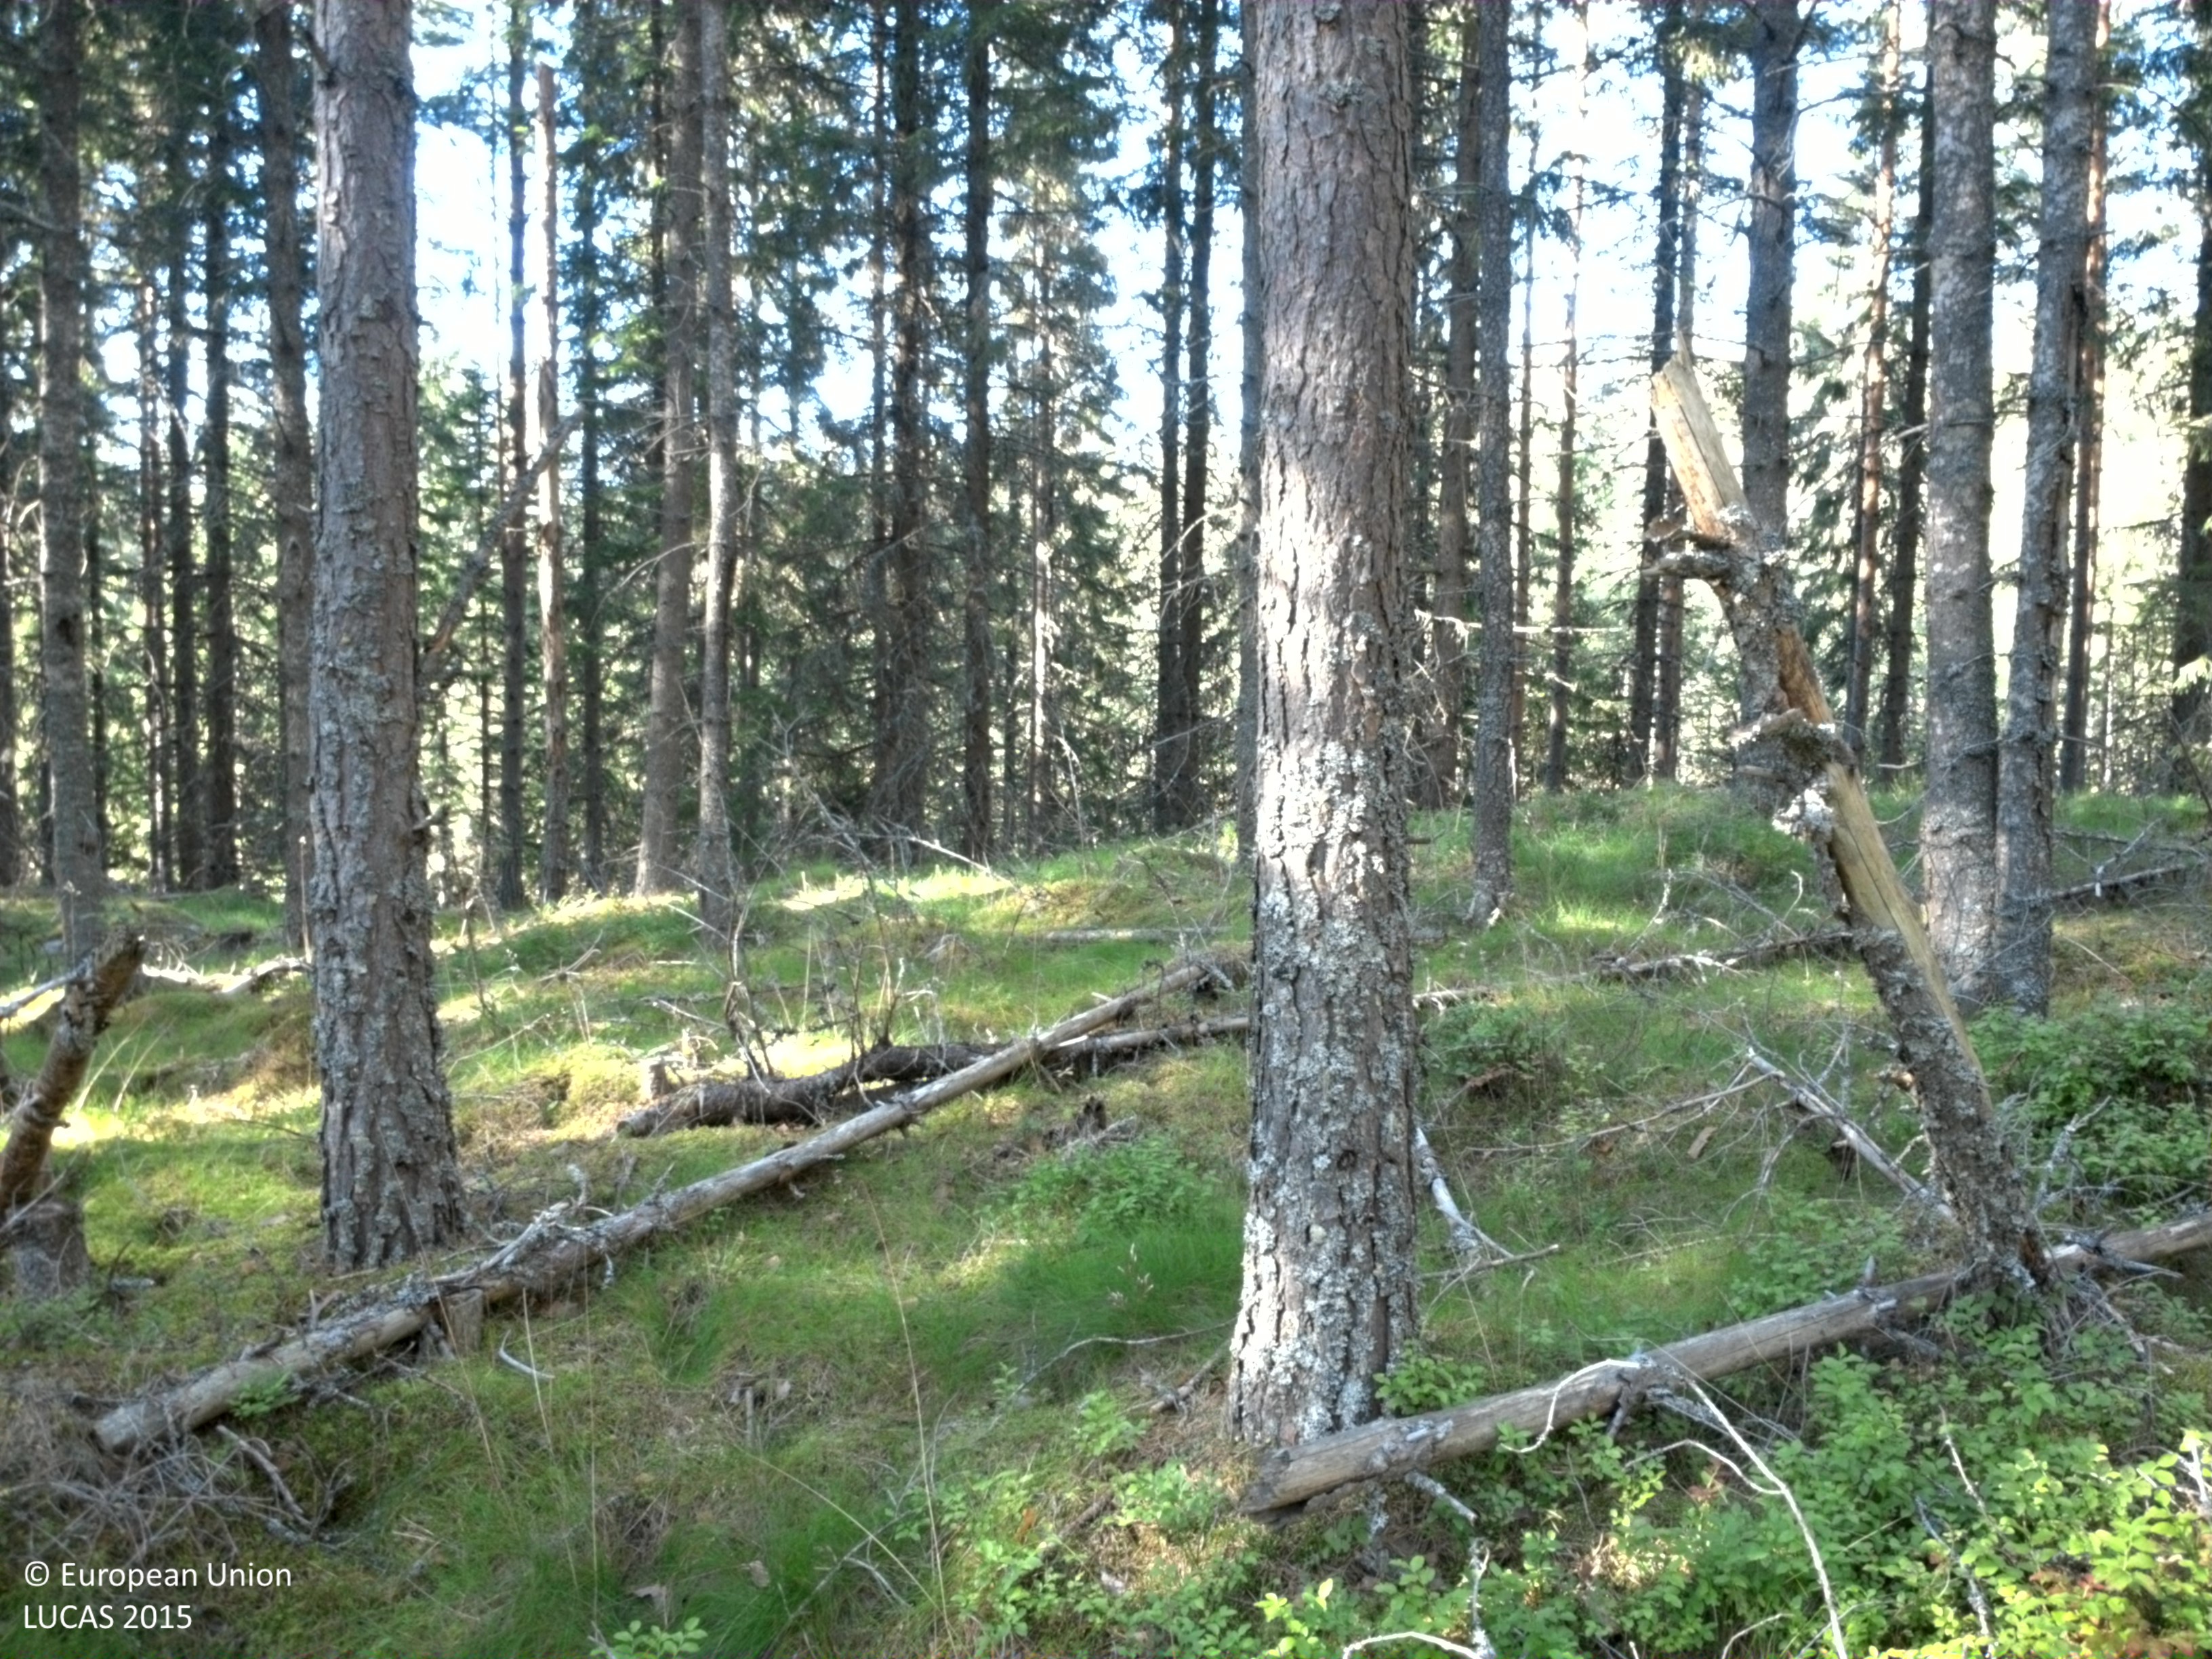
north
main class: Woodland
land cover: Pine dominated coniferous woodland
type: boreal forest
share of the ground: 50 - 75 %
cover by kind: coniferous forest trees 70 %, shrubs 25 %, lichens and mosses 5 %
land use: Forestry
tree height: > 5 m
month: August
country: SE
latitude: 60.1902
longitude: 13.5430
